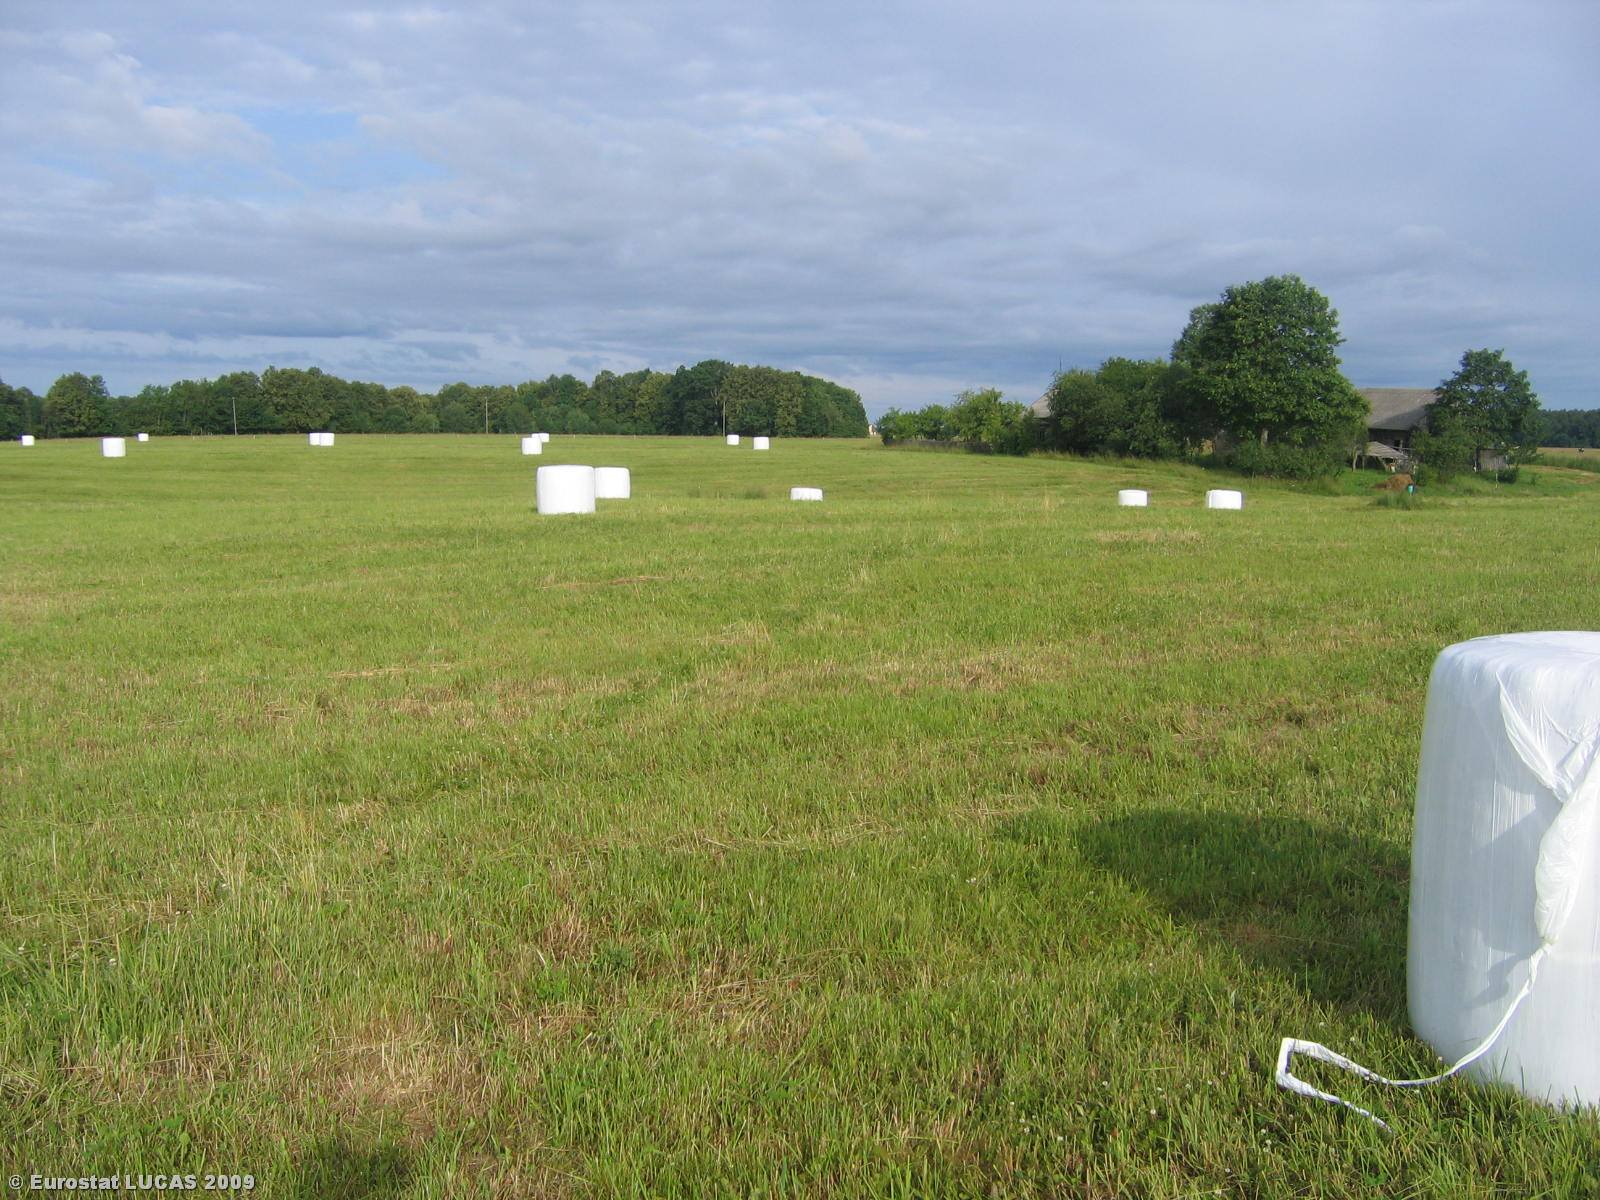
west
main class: Grassland
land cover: Grassland without tree/shrub cover
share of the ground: > 75 %
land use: Agriculture (excluding fallow land and kitchen gardens)
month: July
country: LT
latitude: 55.3324
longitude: 22.7236
